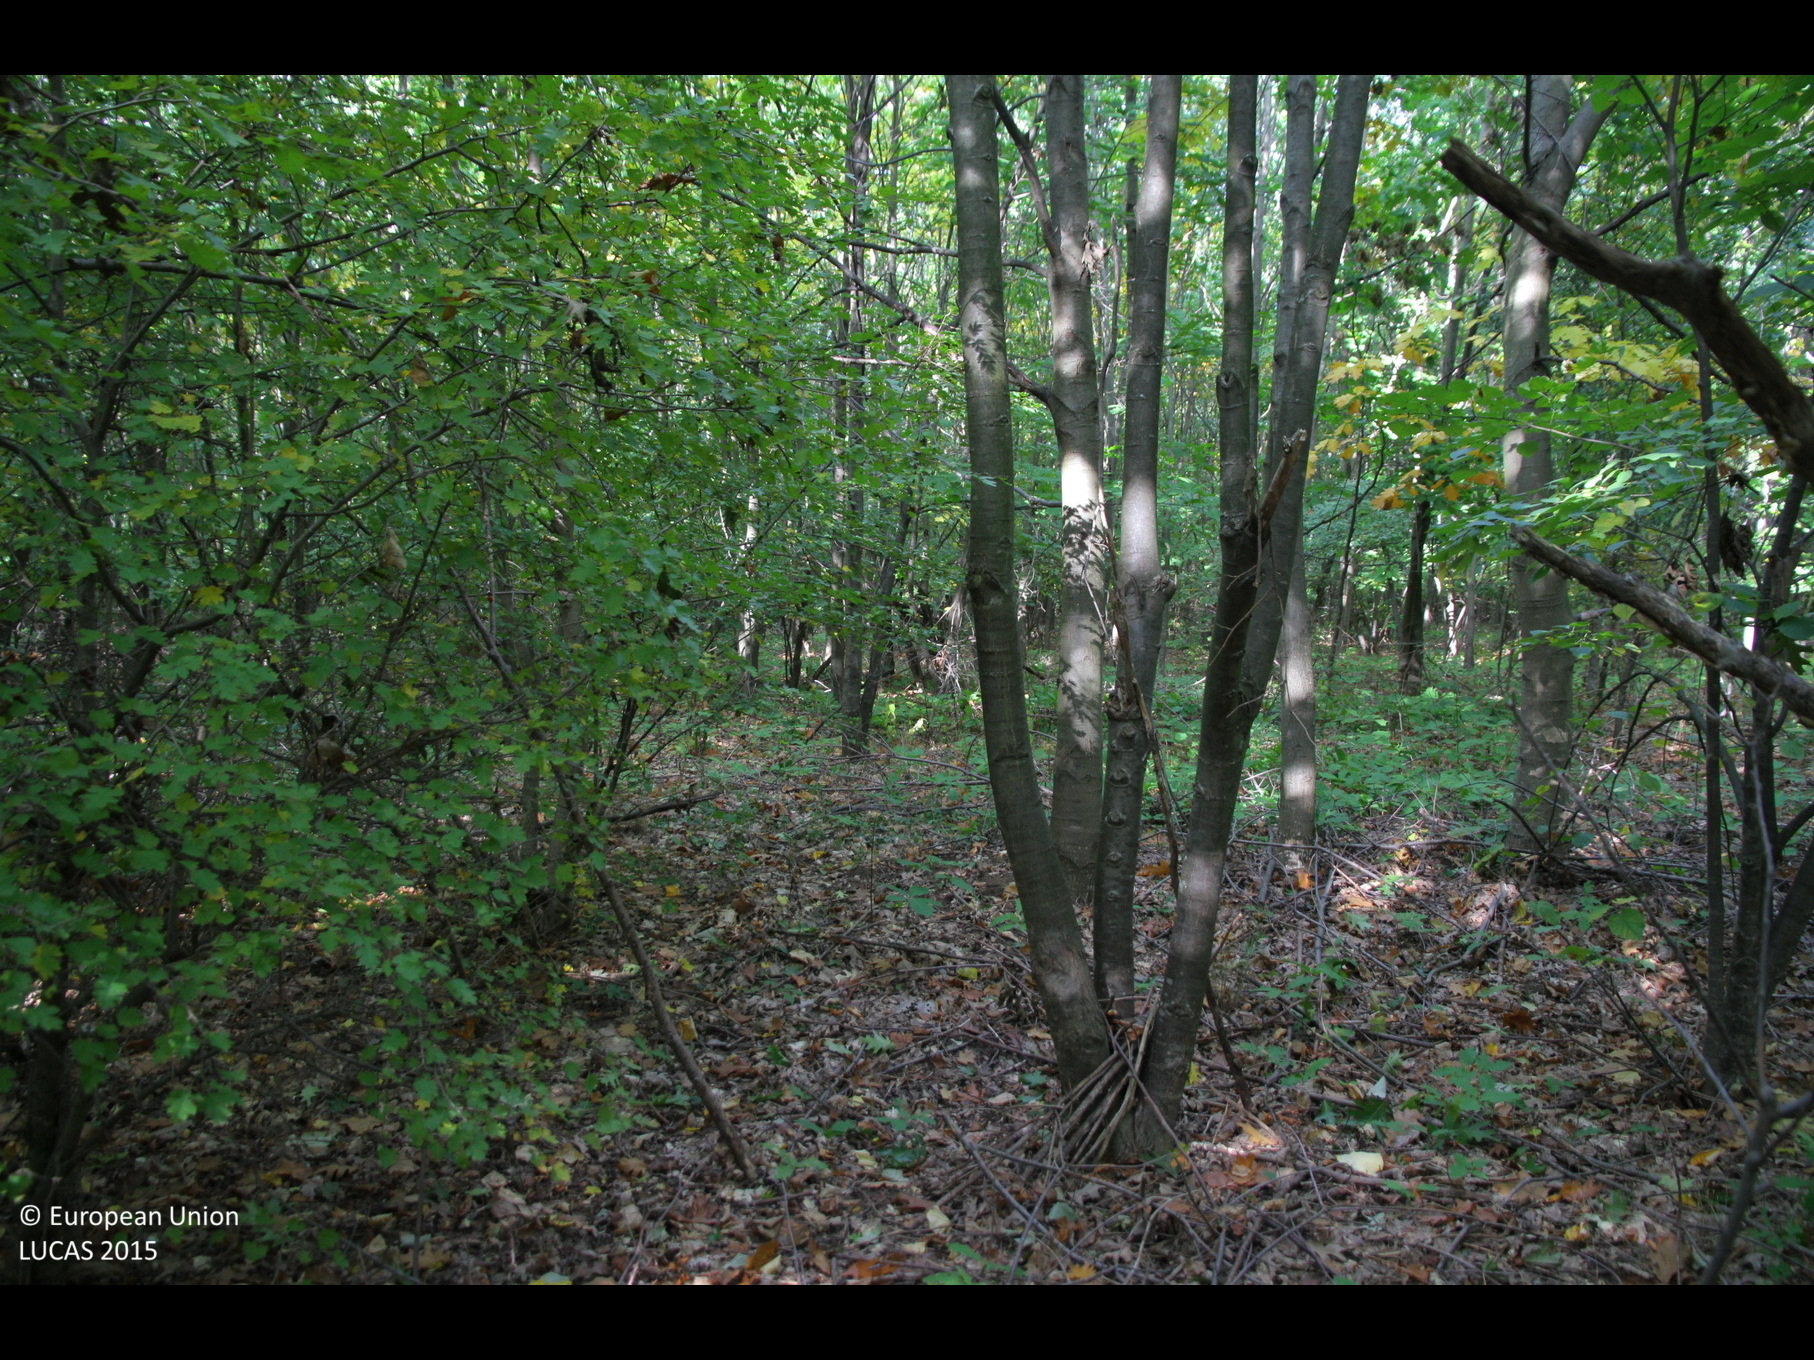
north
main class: Woodland
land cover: Broadleaved woodland
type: acidophilous oak and oak-birch forest
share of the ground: > 75 %
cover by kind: broadleaved forest trees 100 %
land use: Forestry
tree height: > 5 m
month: October
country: BG
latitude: 43.4863
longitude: 27.2236
